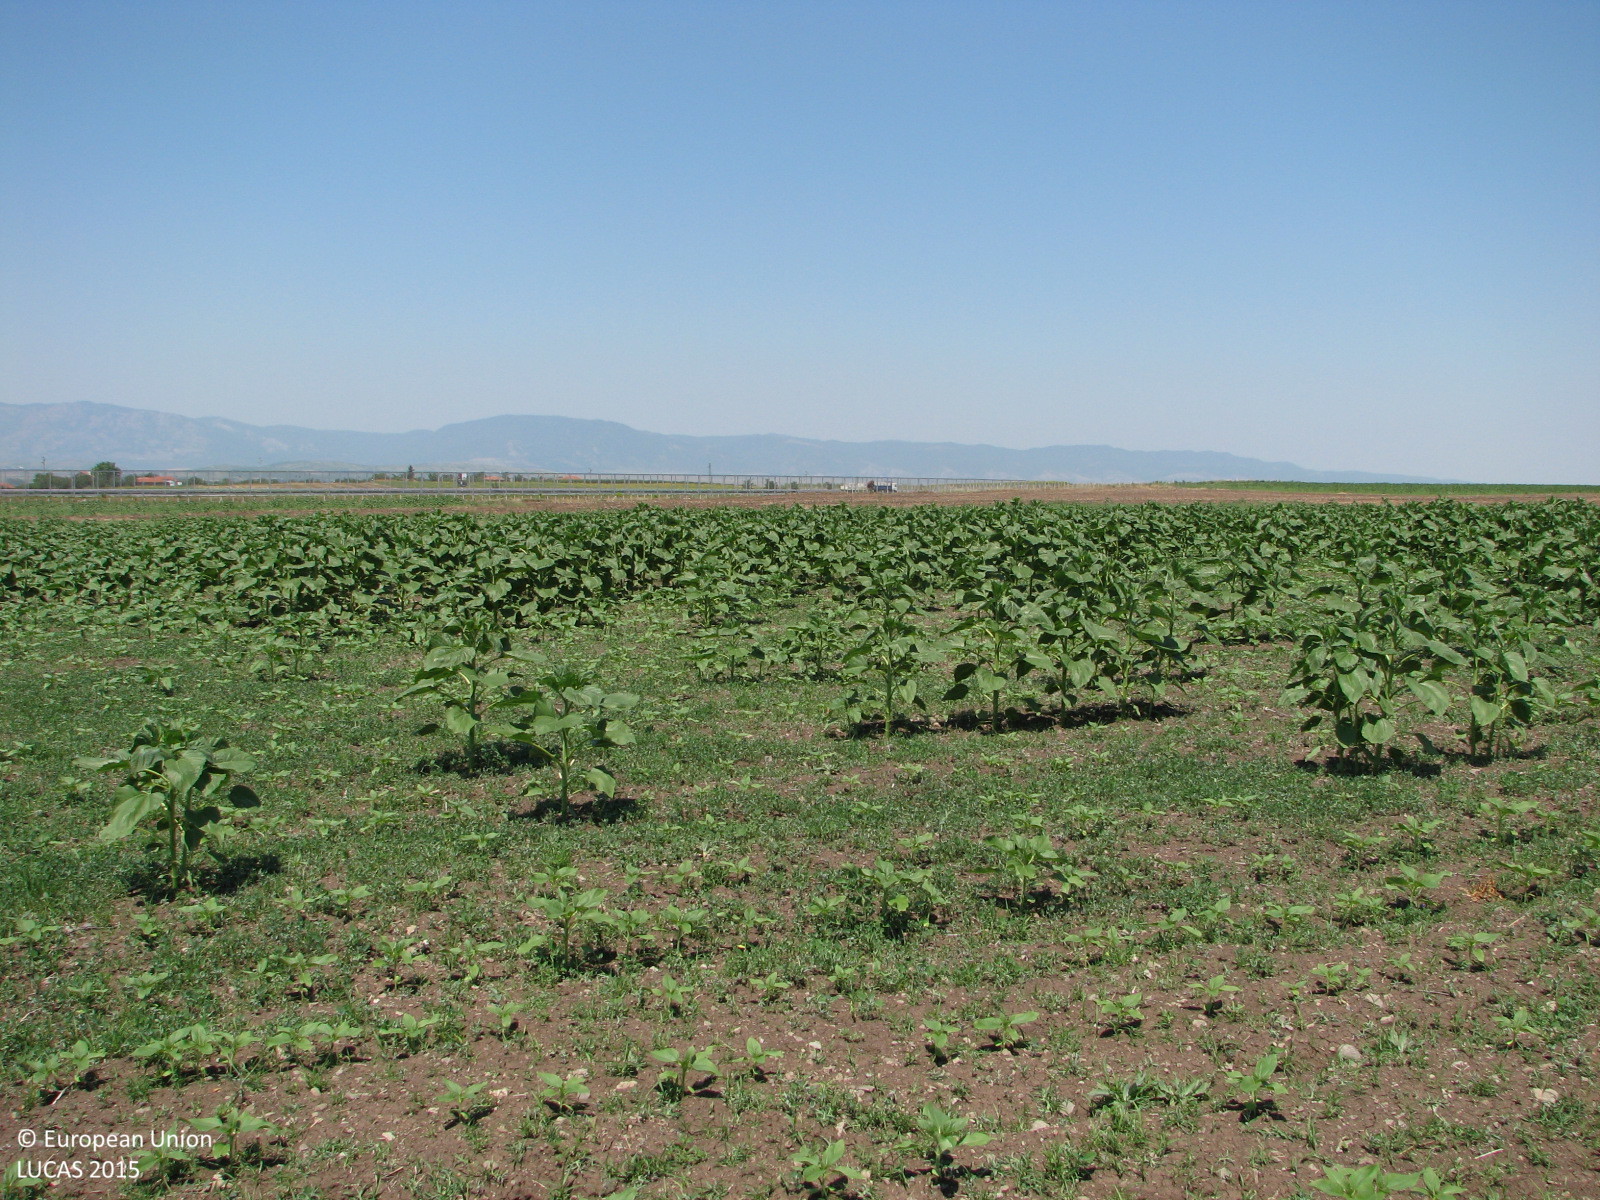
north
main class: Cropland
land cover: Sunflower
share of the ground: 10 - 25 %
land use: Agriculture (excluding fallow land and kitchen gardens)
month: July
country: BG
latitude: 42.5083
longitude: 26.3606
